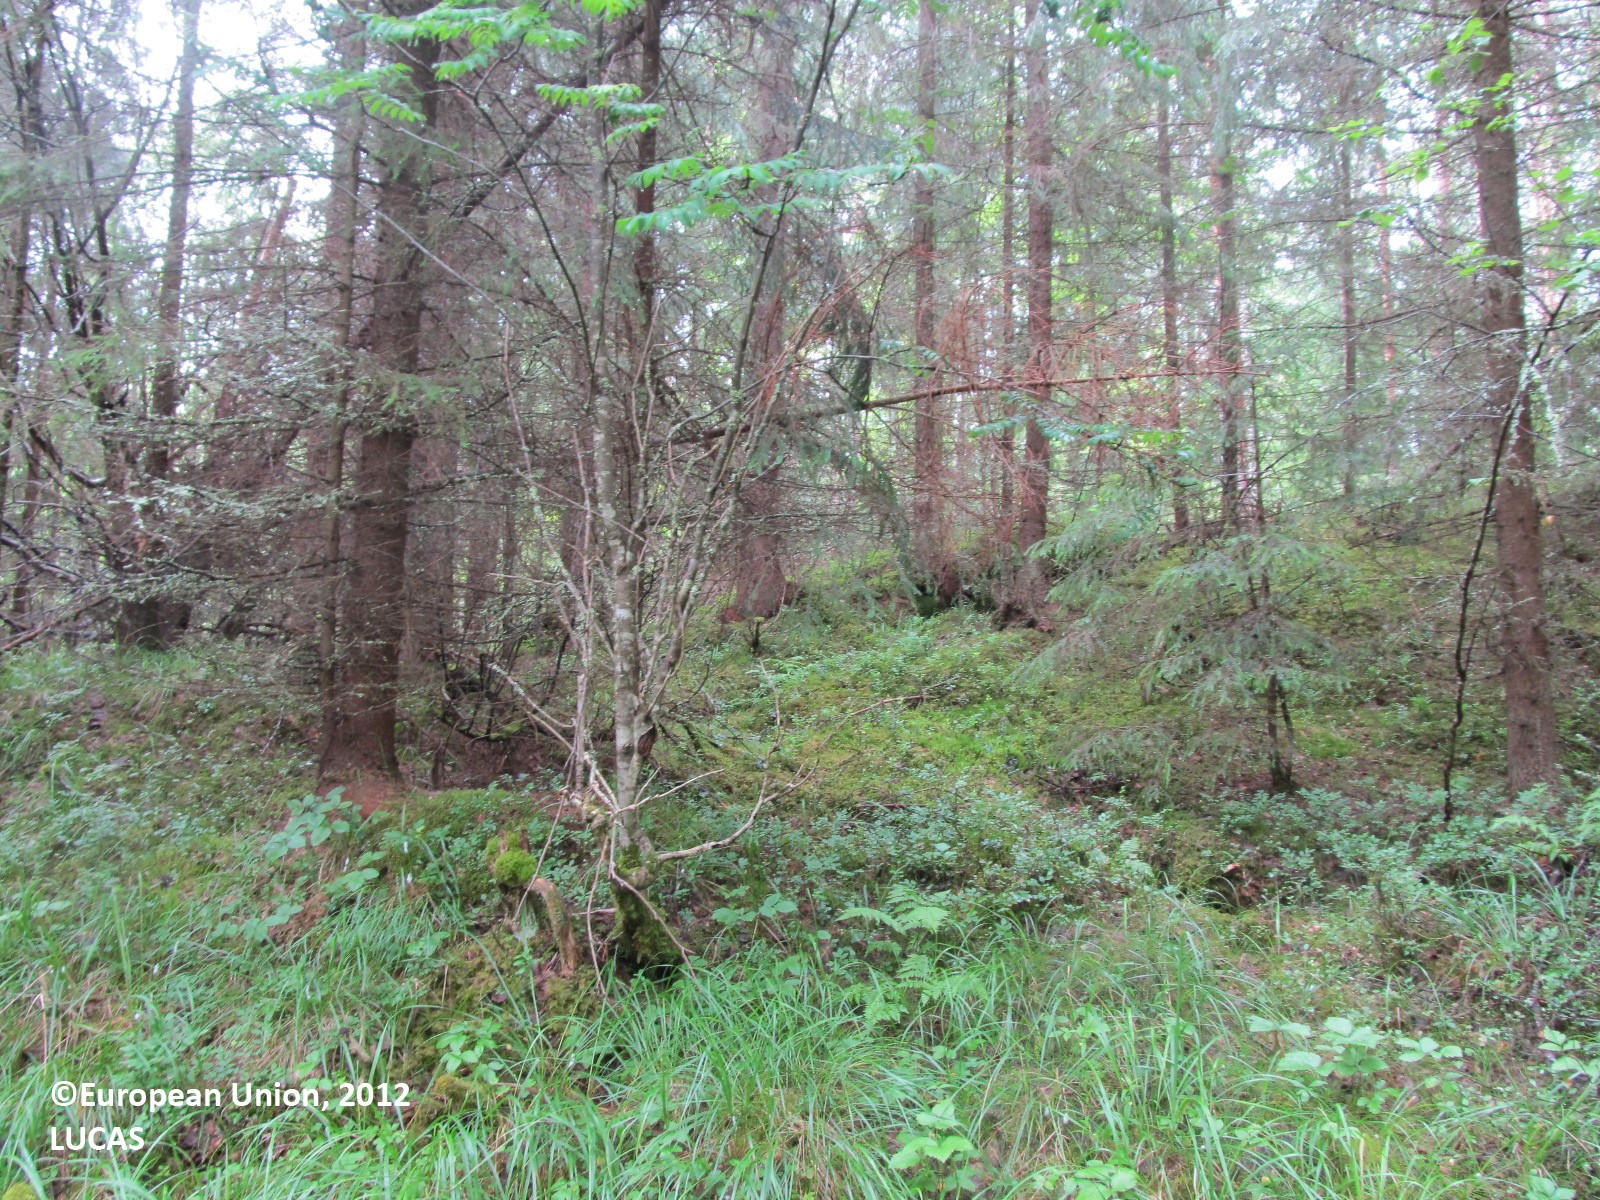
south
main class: Woodland
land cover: Spruce dominated mixed woodland
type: boreal forest
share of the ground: 25 - 50 %
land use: Forestry
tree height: > 5 m
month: July
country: FI
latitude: 61.8618
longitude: 28.4737
